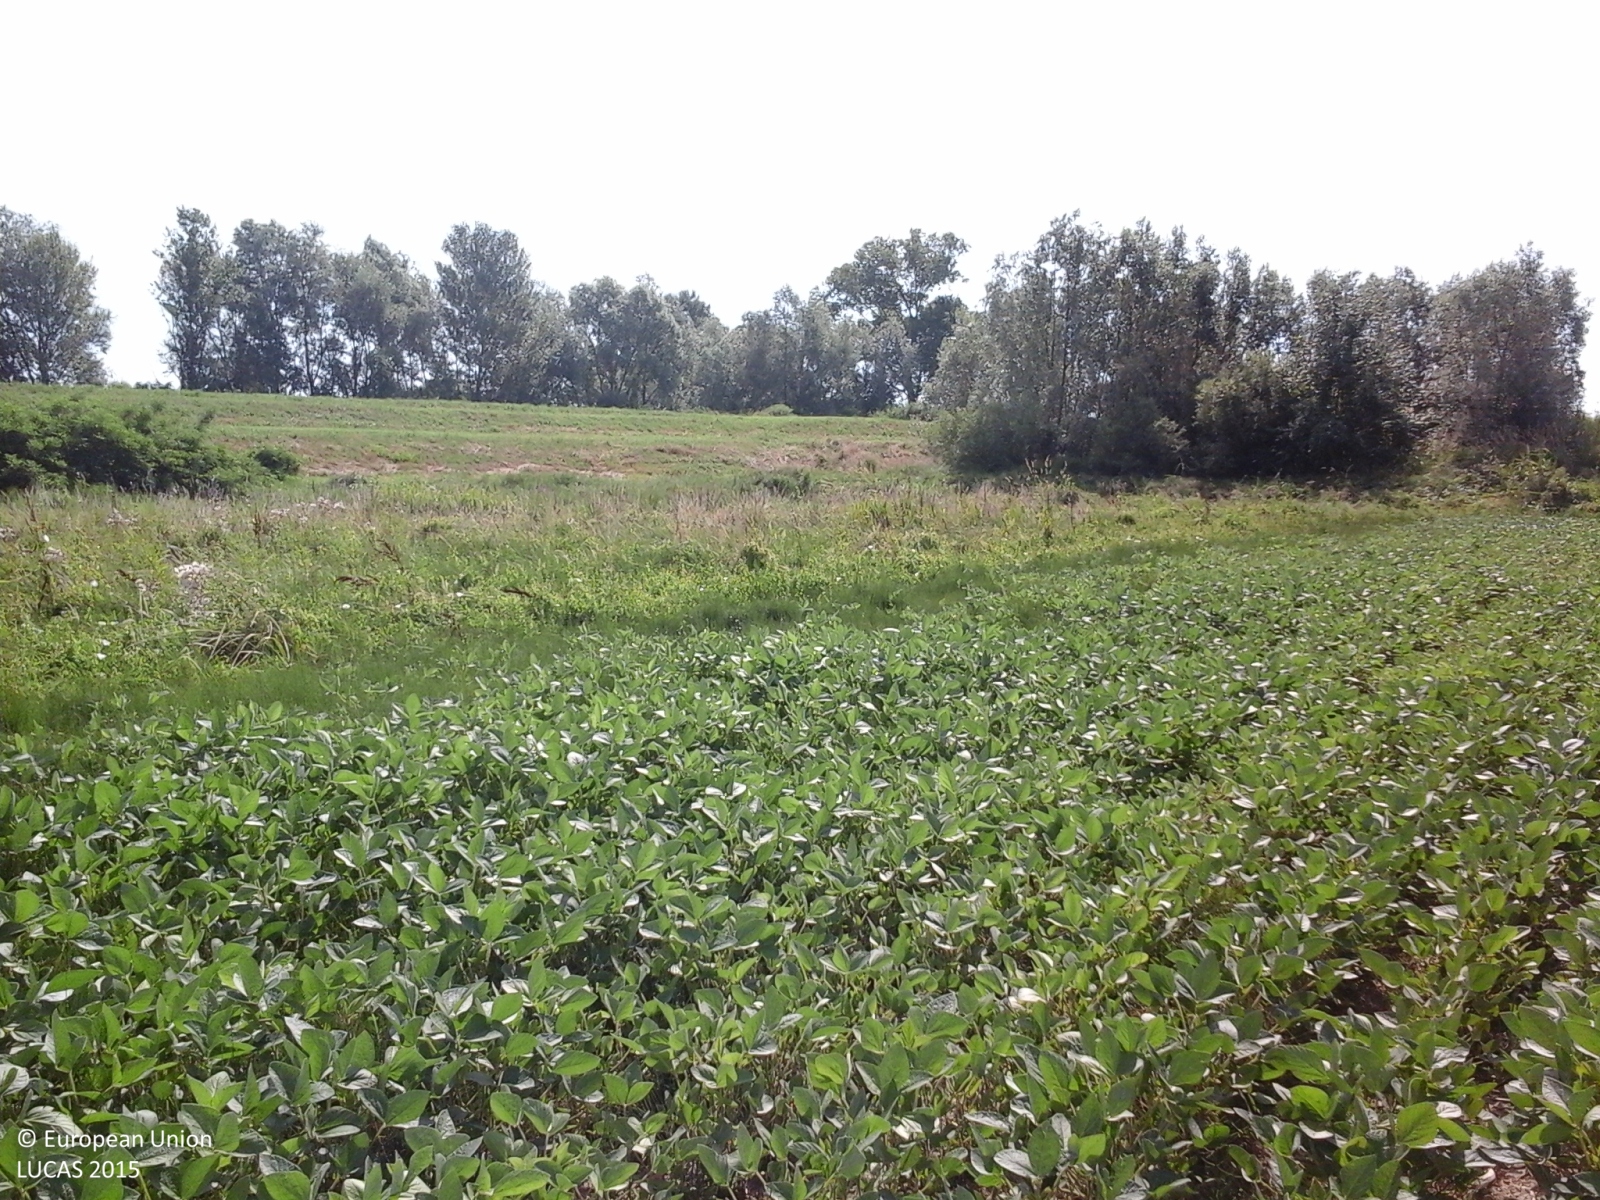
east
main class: Cropland
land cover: Soya
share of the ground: > 75 %
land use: Agriculture (excluding fallow land and kitchen gardens)
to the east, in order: Soya; Ditches and canals; Shrubland without tree cover; Grassland without tree/shrub cover; Paved roads, cycling and walking lanes; Shrubland without tree cover; Broadleaved woodland; Inland fresh running water; Shrubland with sparse tree cover
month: June
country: IT
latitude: 44.9538
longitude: 12.4167
